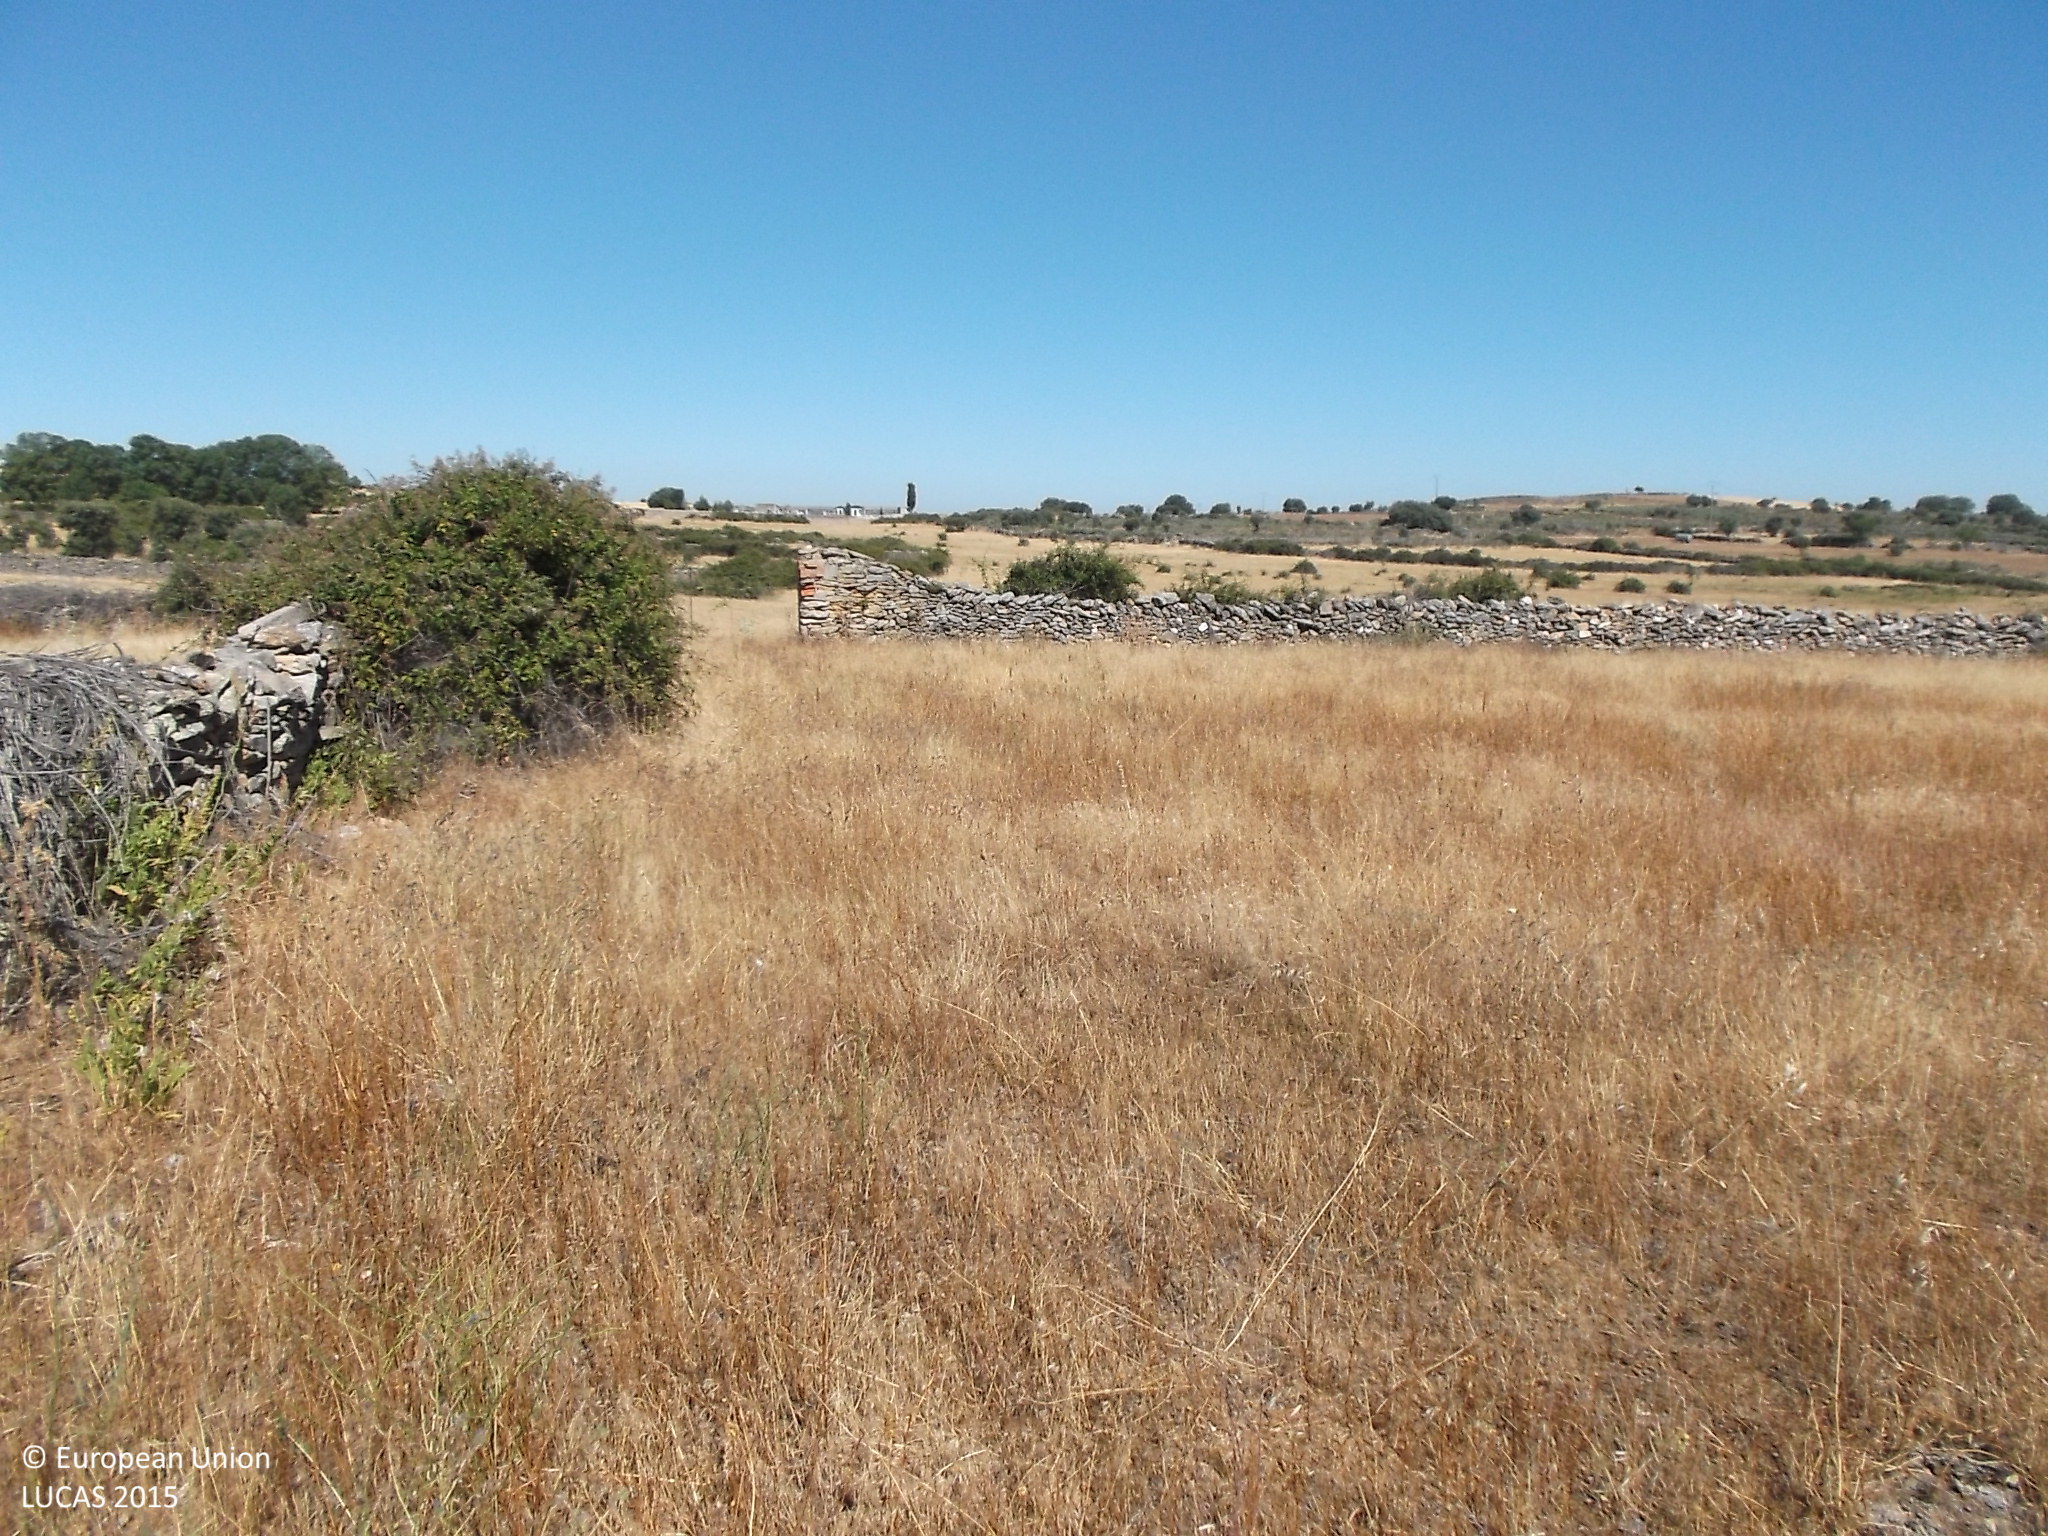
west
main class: Grassland
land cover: Grassland without tree/shrub cover
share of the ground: > 75 %
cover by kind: herbaceous plants 100 %
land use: Agriculture (excluding fallow land and kitchen gardens)
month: June
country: ES
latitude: 40.9108
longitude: -6.7811
